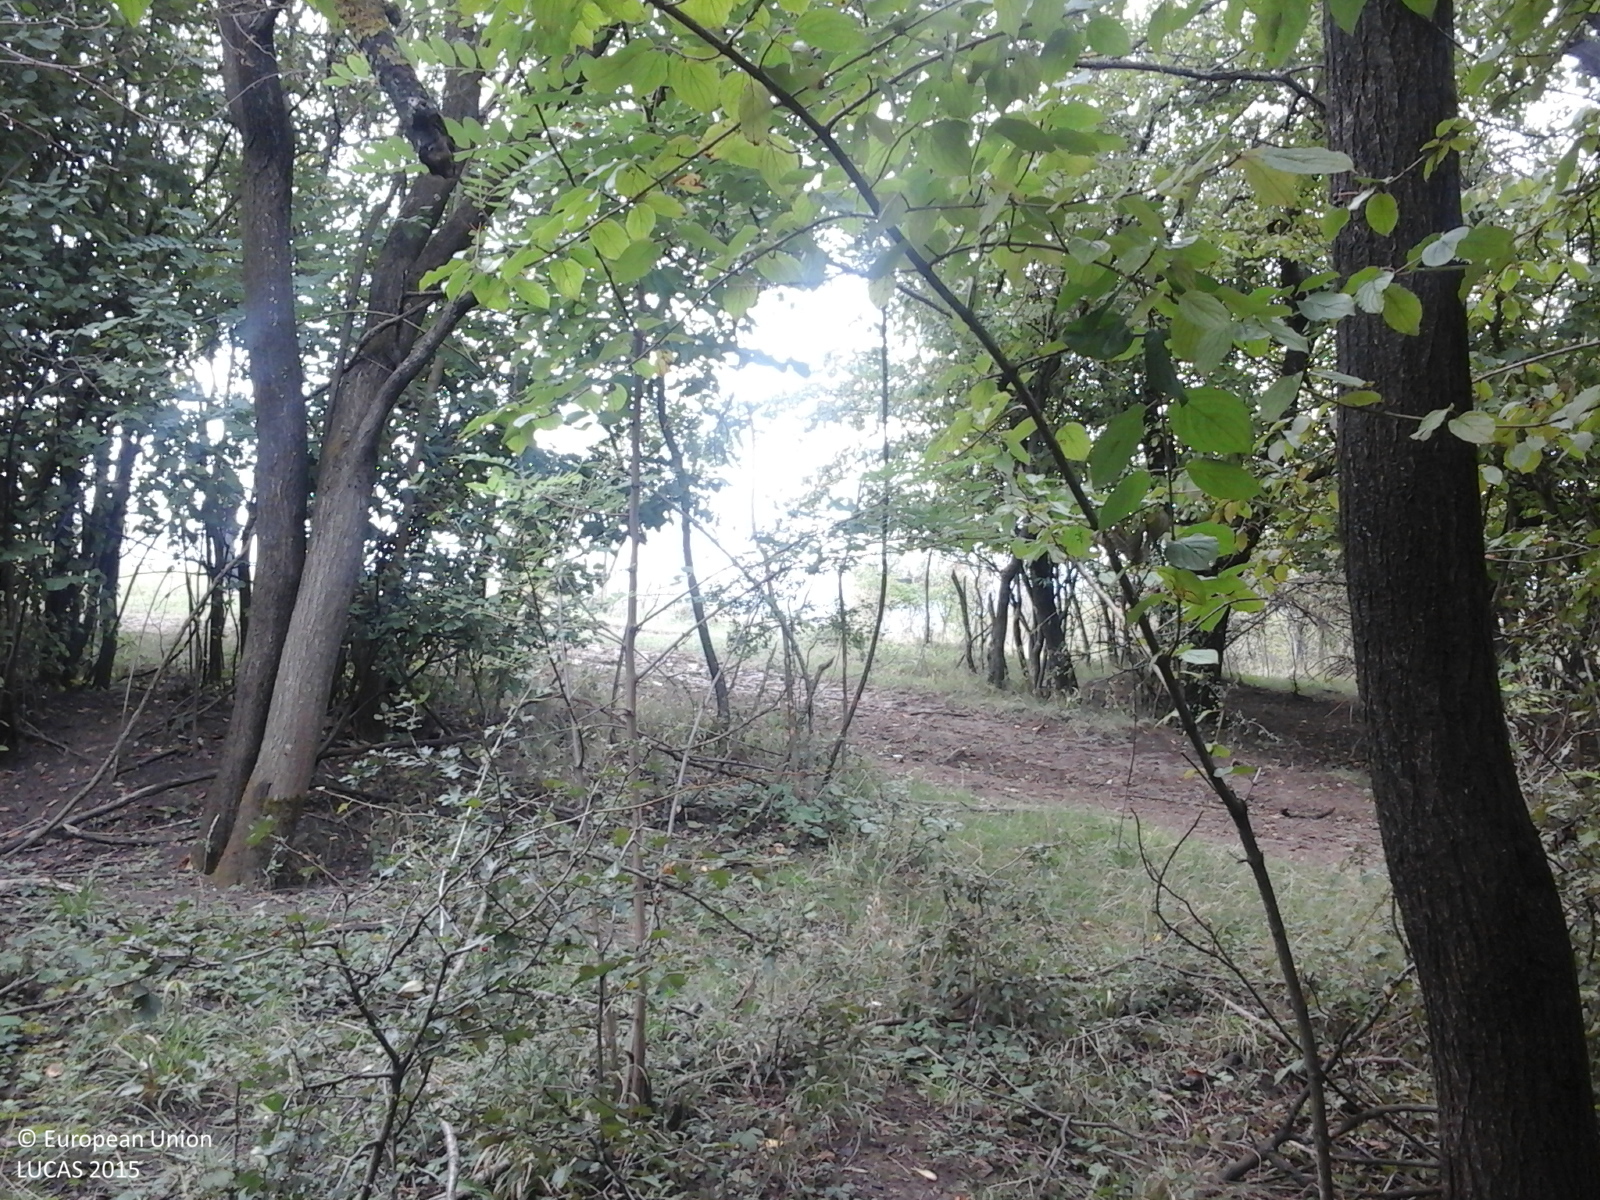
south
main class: Woodland
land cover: Broadleaved woodland
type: mesophytic deciduous forest
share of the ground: > 75 %
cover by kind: broadleaved forest trees 100 %
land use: Forestry
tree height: > 5 m
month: September
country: RO
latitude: 47.0692
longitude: 22.3648
